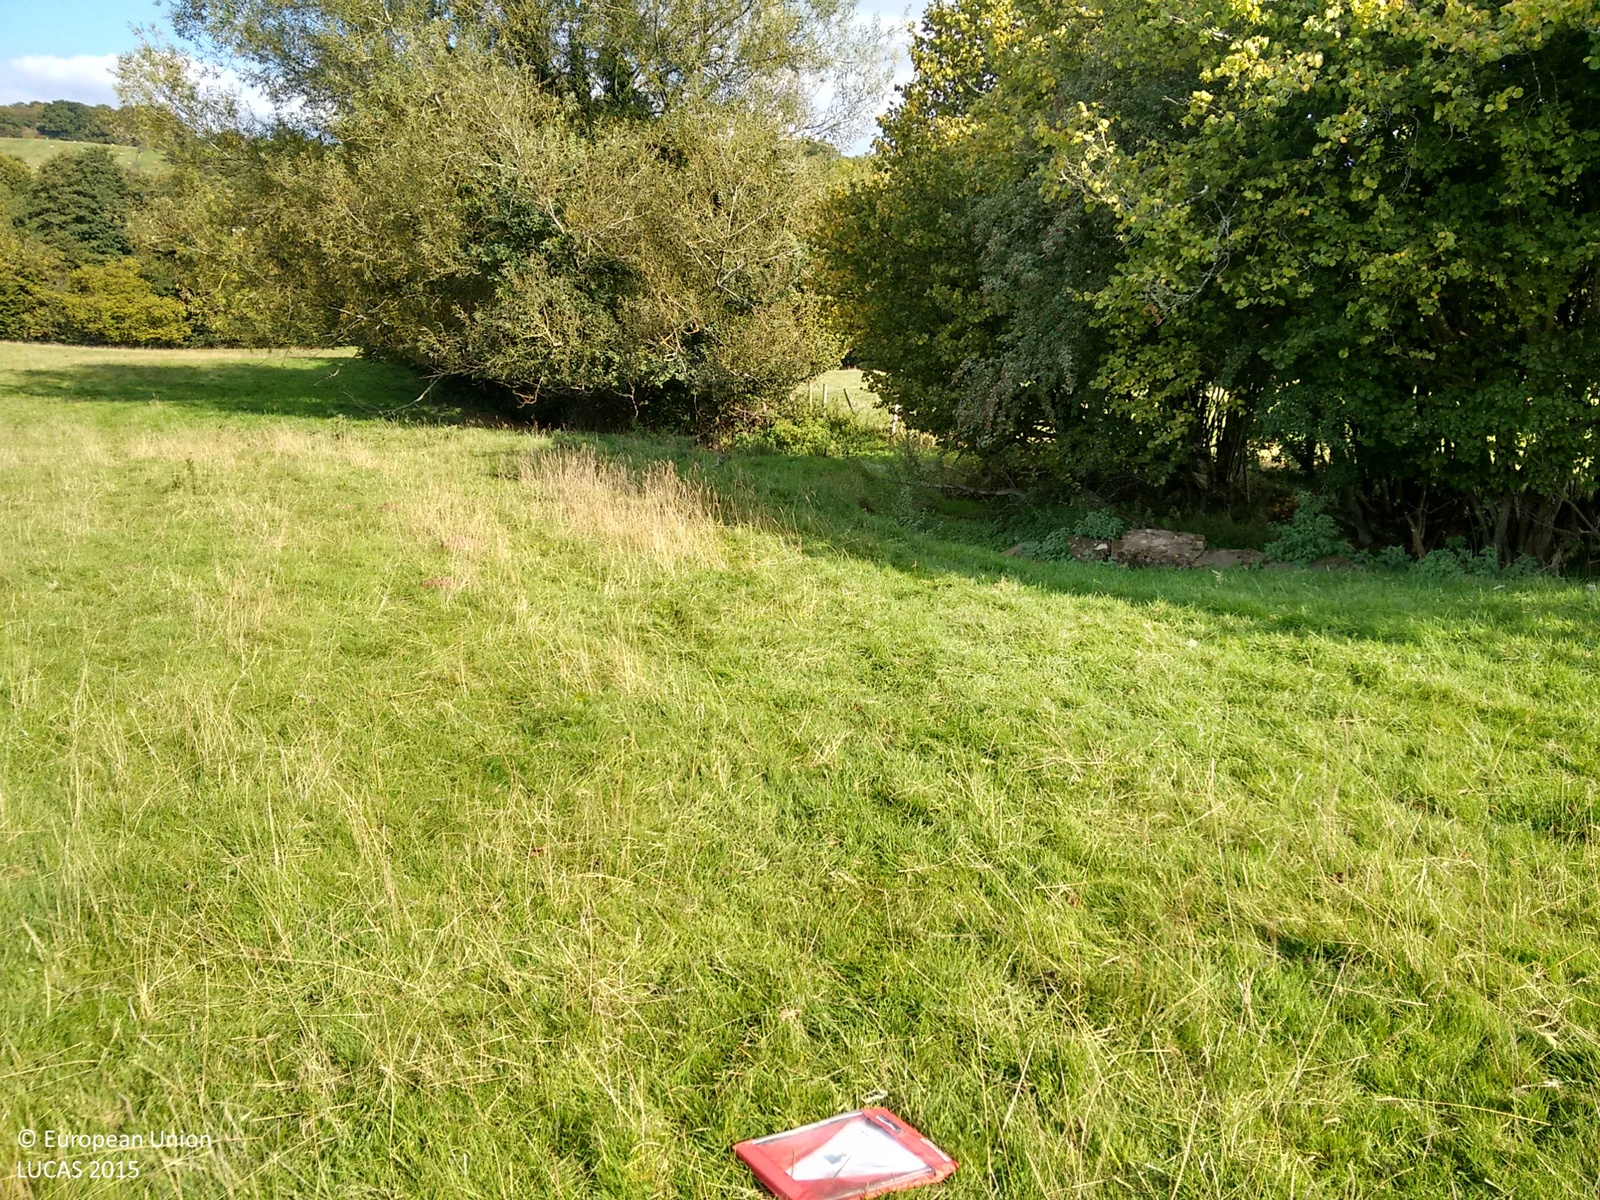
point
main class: Grassland
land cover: Grassland without tree/shrub cover
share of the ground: > 75 %
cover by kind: herbaceous plants 100 %
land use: Agriculture (excluding fallow land and kitchen gardens)
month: September
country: GB
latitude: 51.8642
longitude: -2.4528
